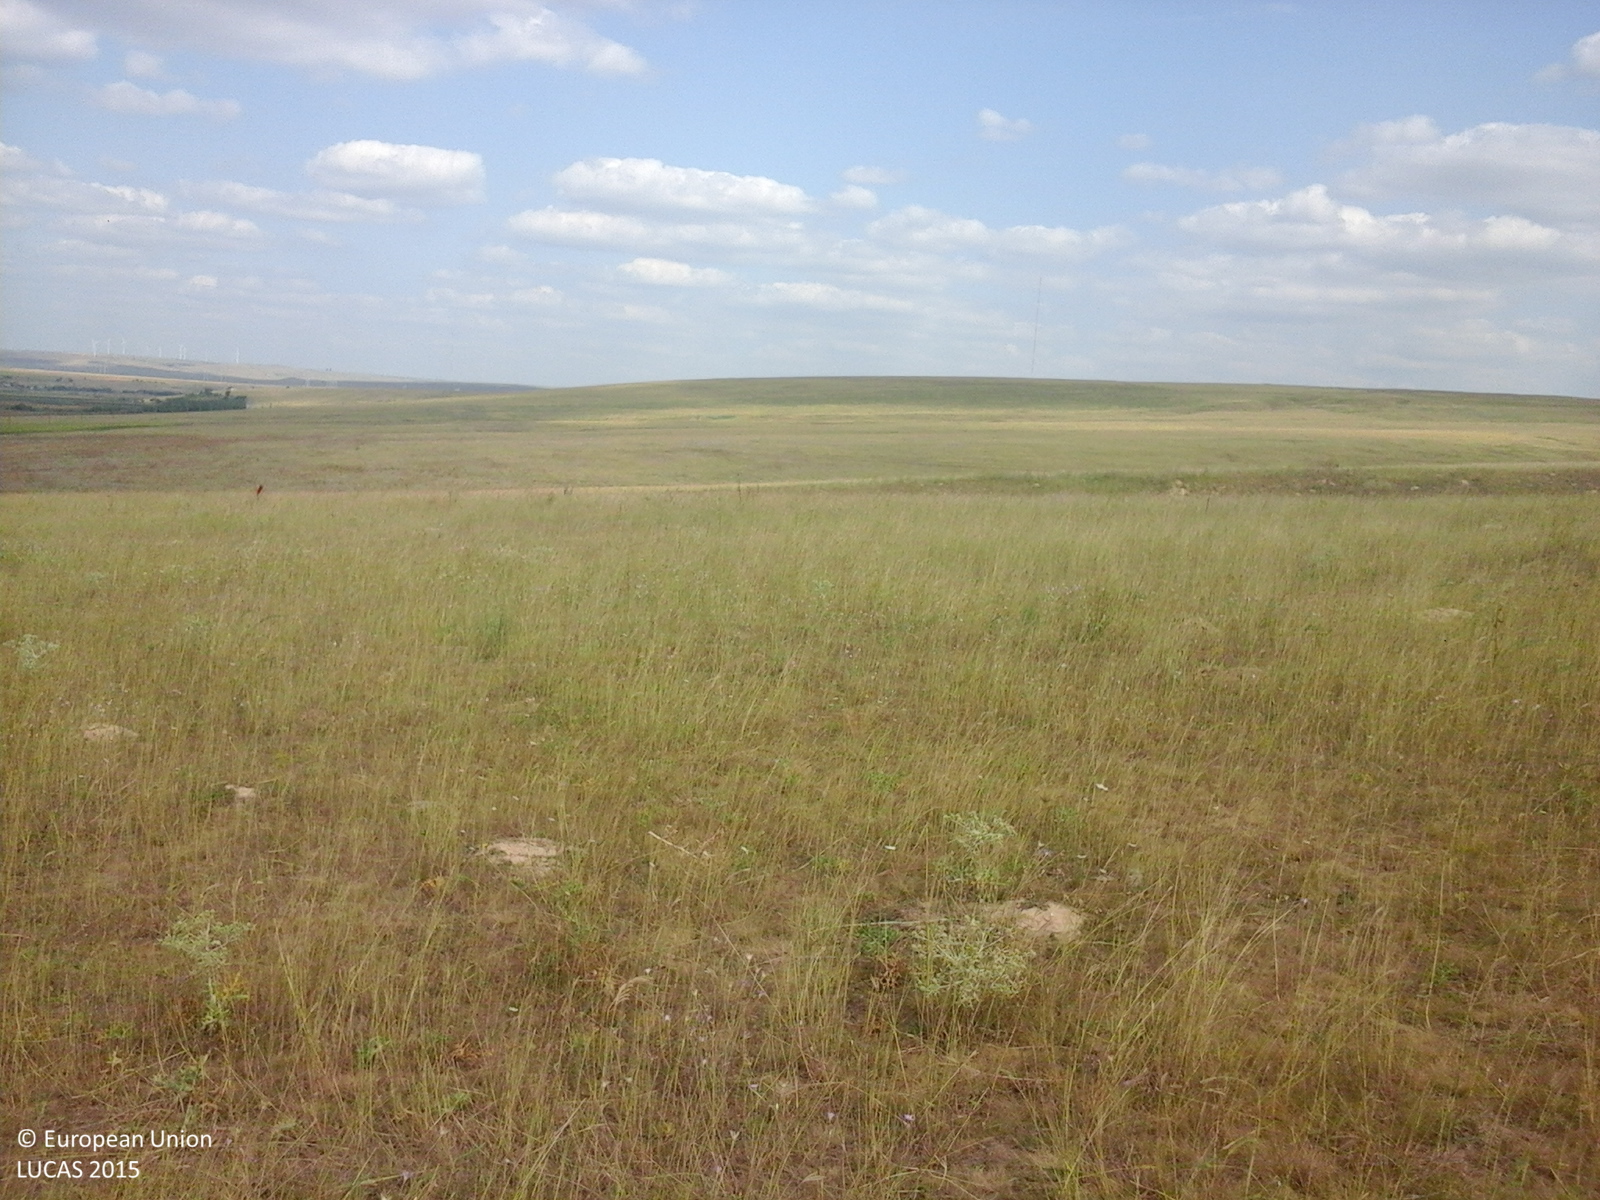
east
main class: Grassland
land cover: Grassland without tree/shrub cover
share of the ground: > 75 %
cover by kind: herbaceous plants 100 %
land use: Agriculture (excluding fallow land and kitchen gardens)
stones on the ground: < 10 %
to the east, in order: Grassland without tree/shrub cover
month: August
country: RO
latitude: 44.7205
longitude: 28.1815
